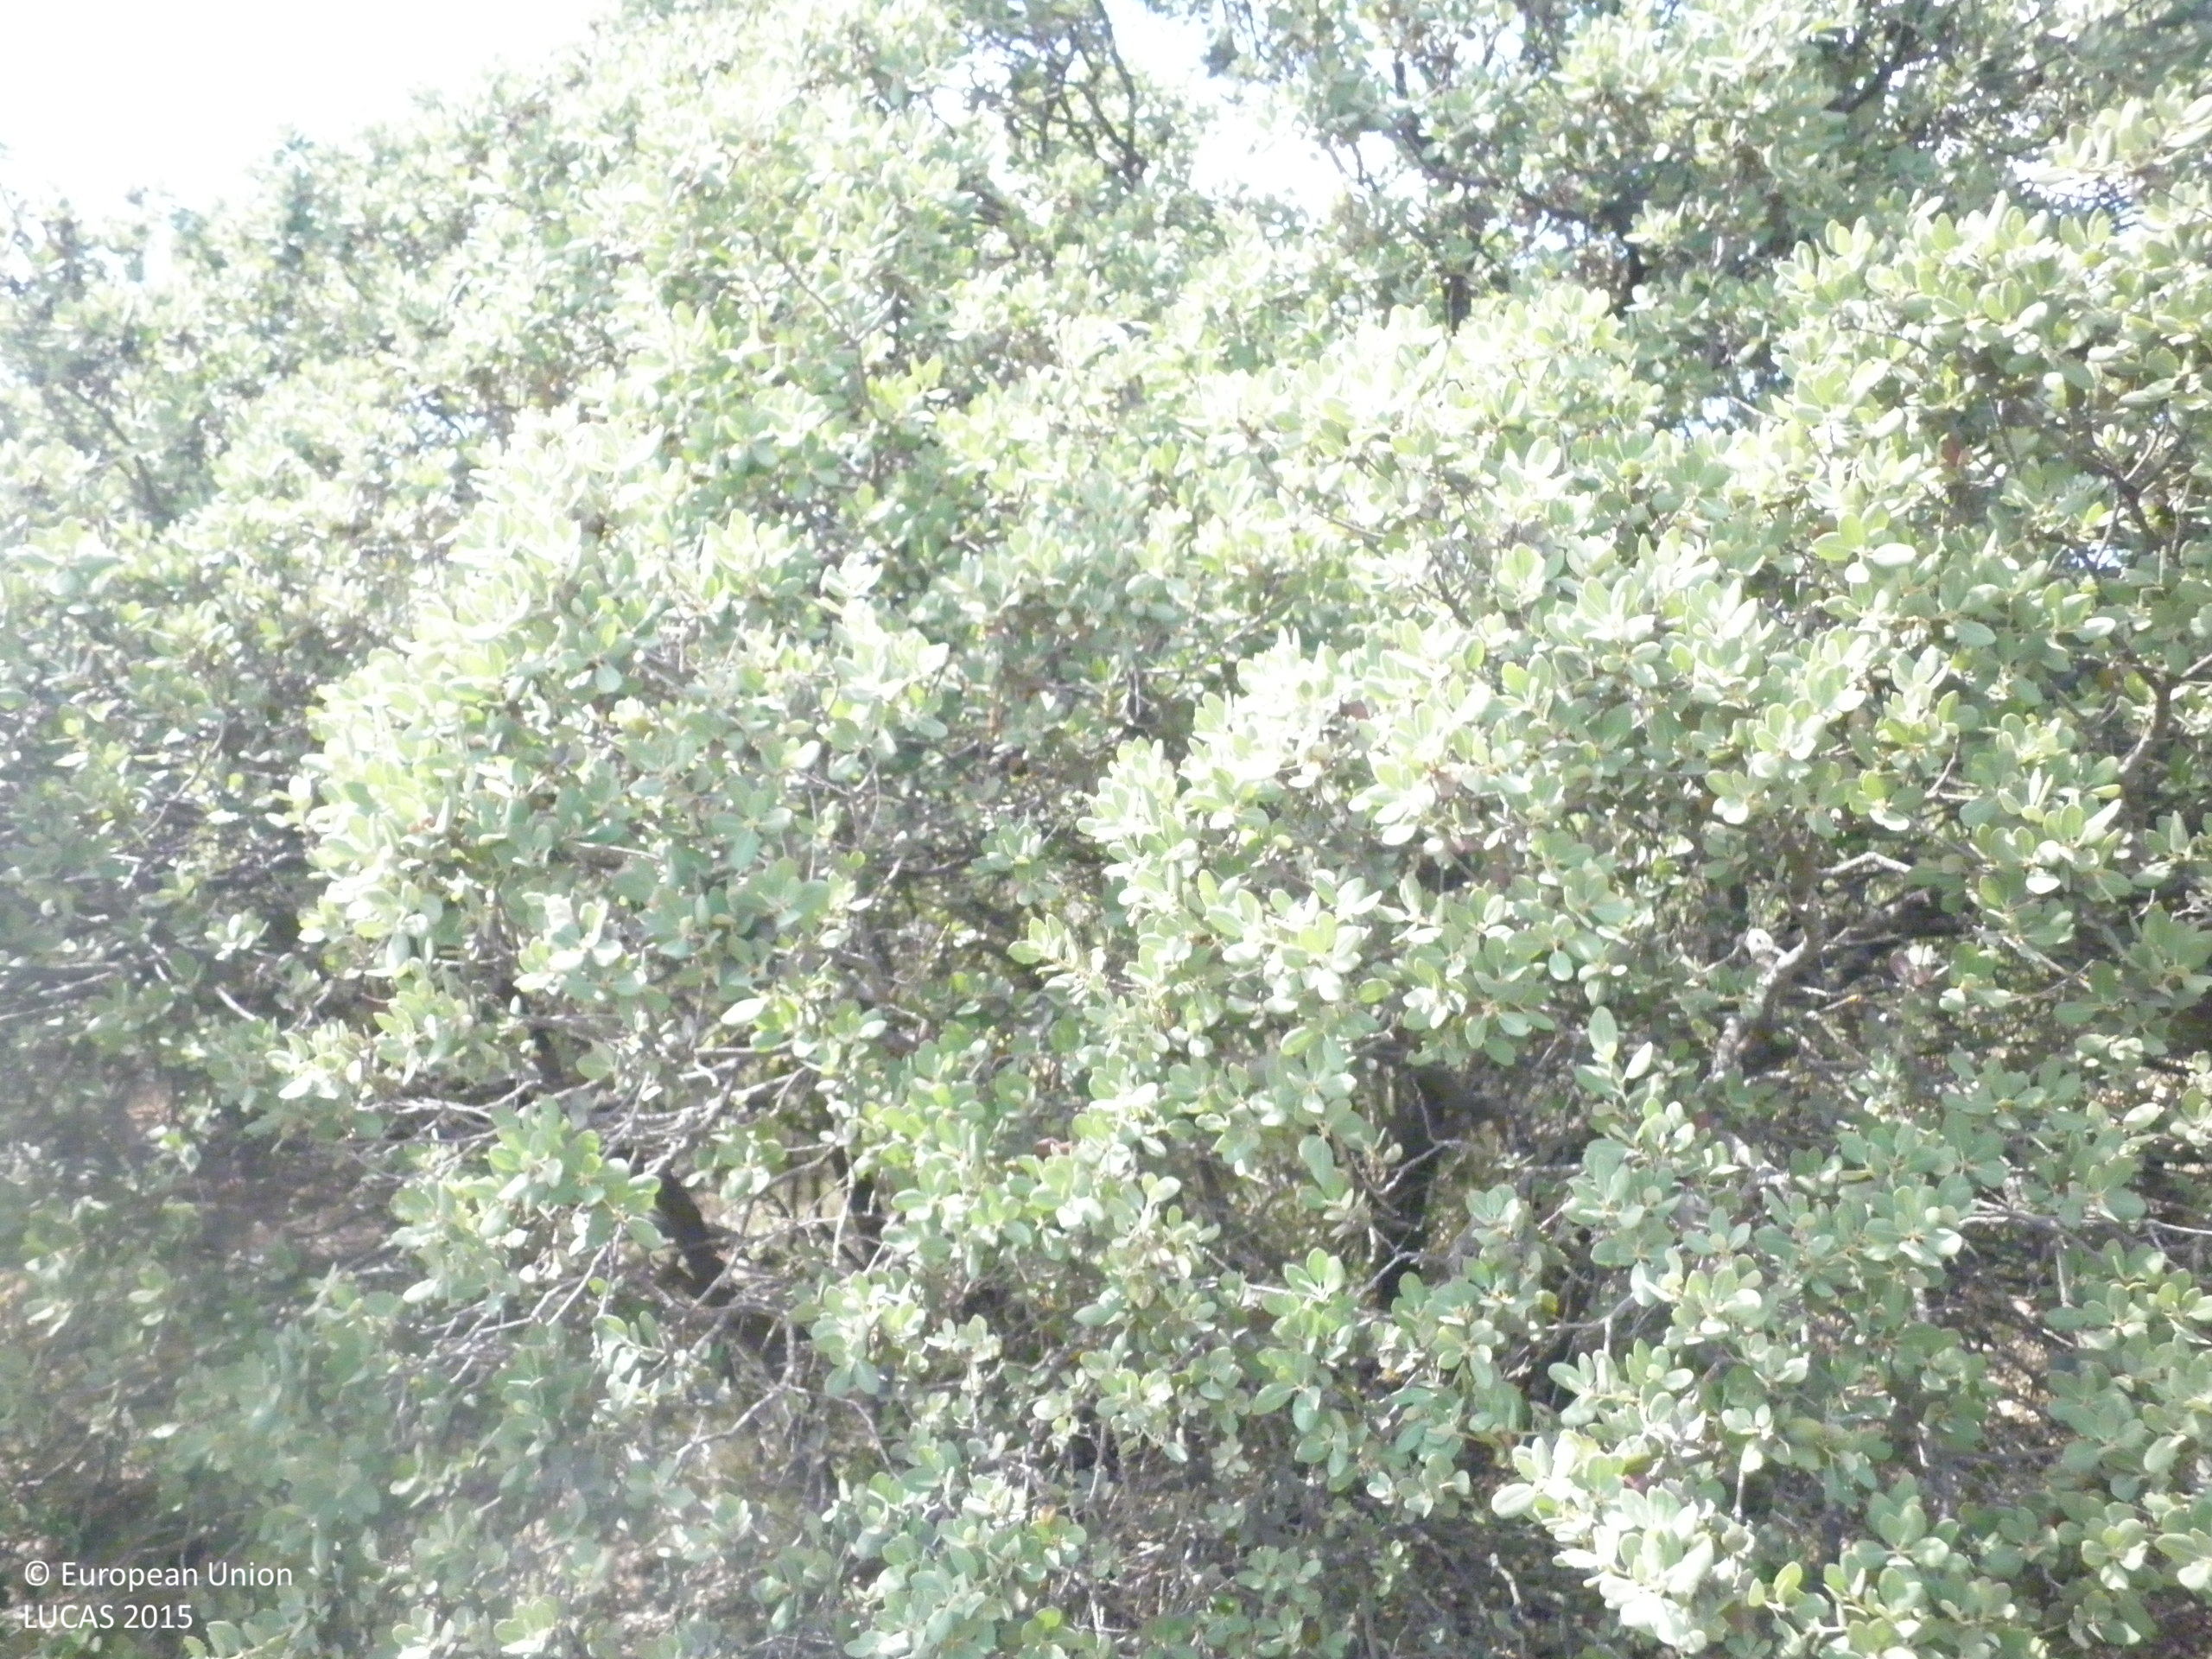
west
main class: Woodland
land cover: Broadleaved woodland
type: broadleaved evergreen forest
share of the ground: 25 - 50 %
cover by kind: shrubs 30 %, broadleaved forest trees 25 %, herbaceous plants 15 %, consolidated bare surface 15 %, unconsolidated bare surface 15 %
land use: Semi-natural and natural areas not in use
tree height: < 5 m
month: May
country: ES
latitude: 39.6594
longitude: -2.8269
